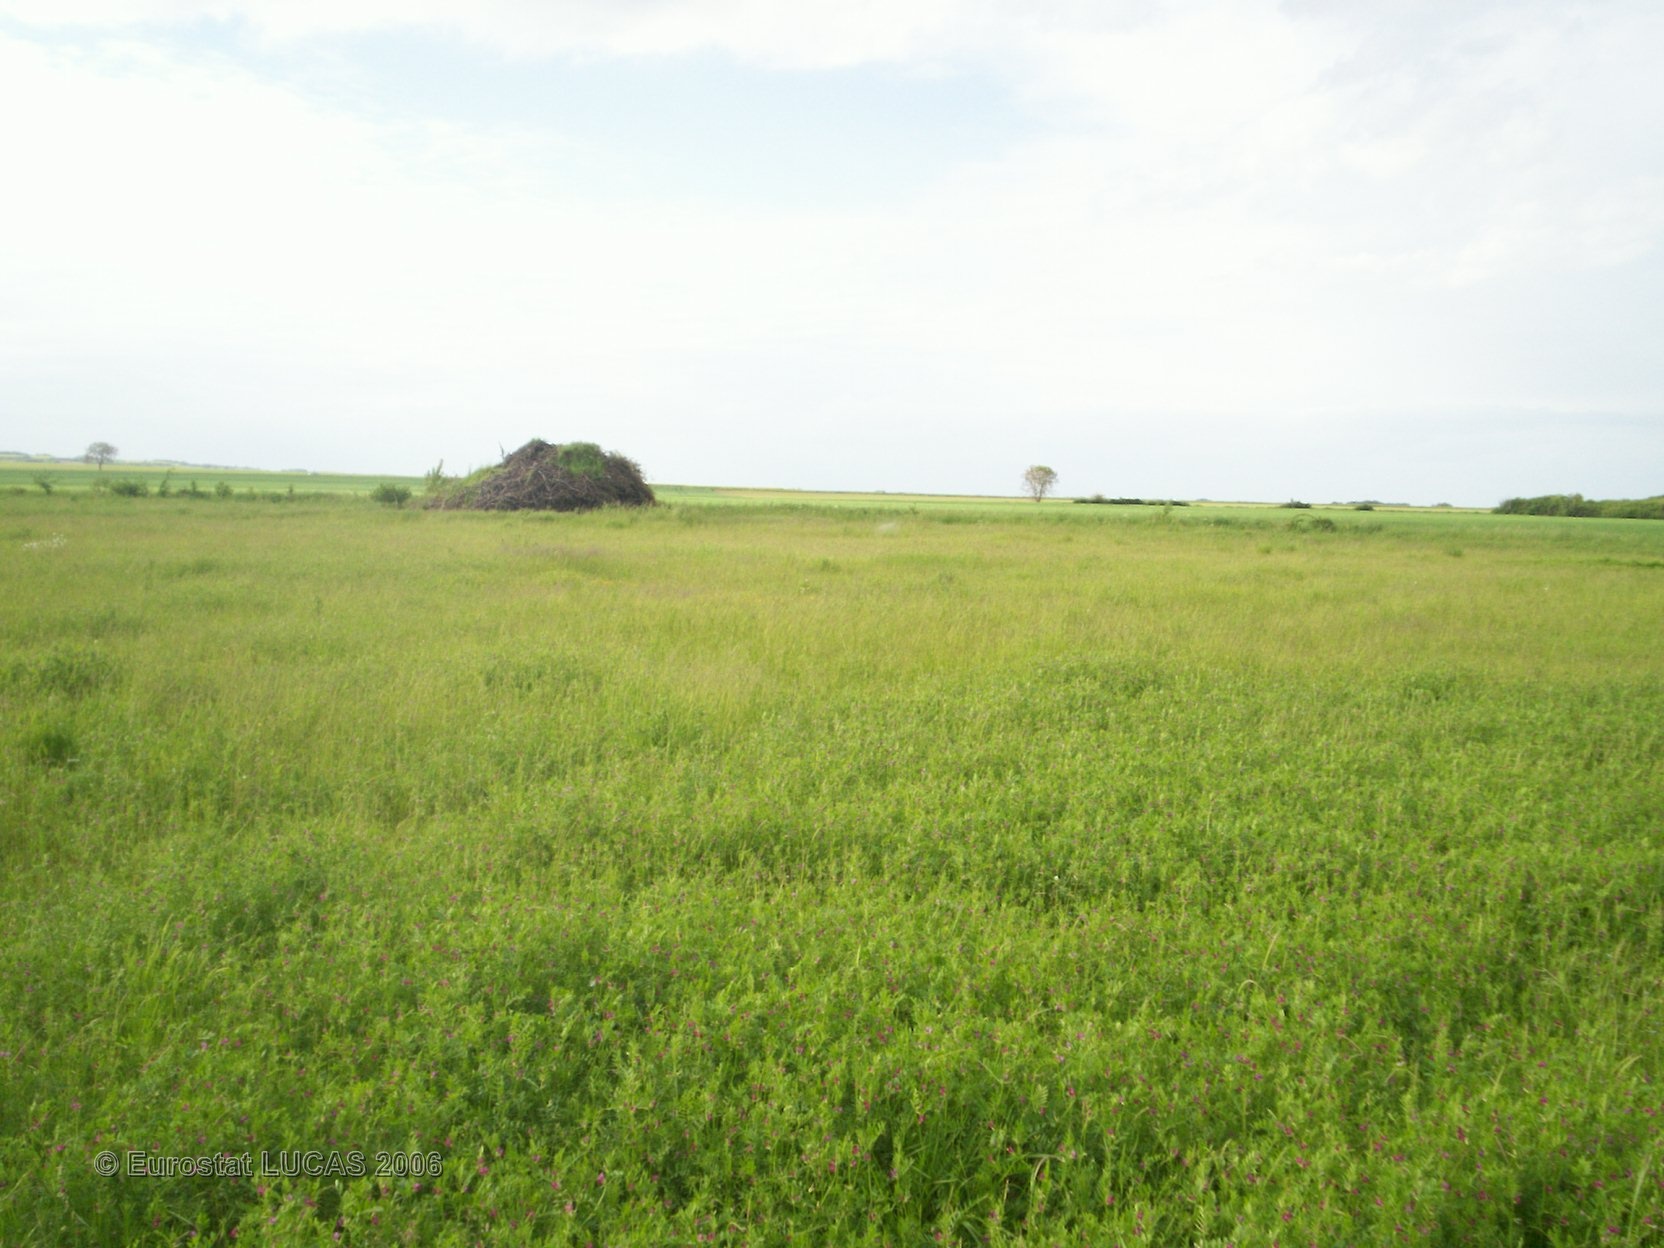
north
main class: Grassland
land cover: Grassland without tree/shrub cover
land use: Agriculture (excluding fallow land and kitchen gardens)
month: May
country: FR
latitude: 46.1545
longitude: 3.2269
